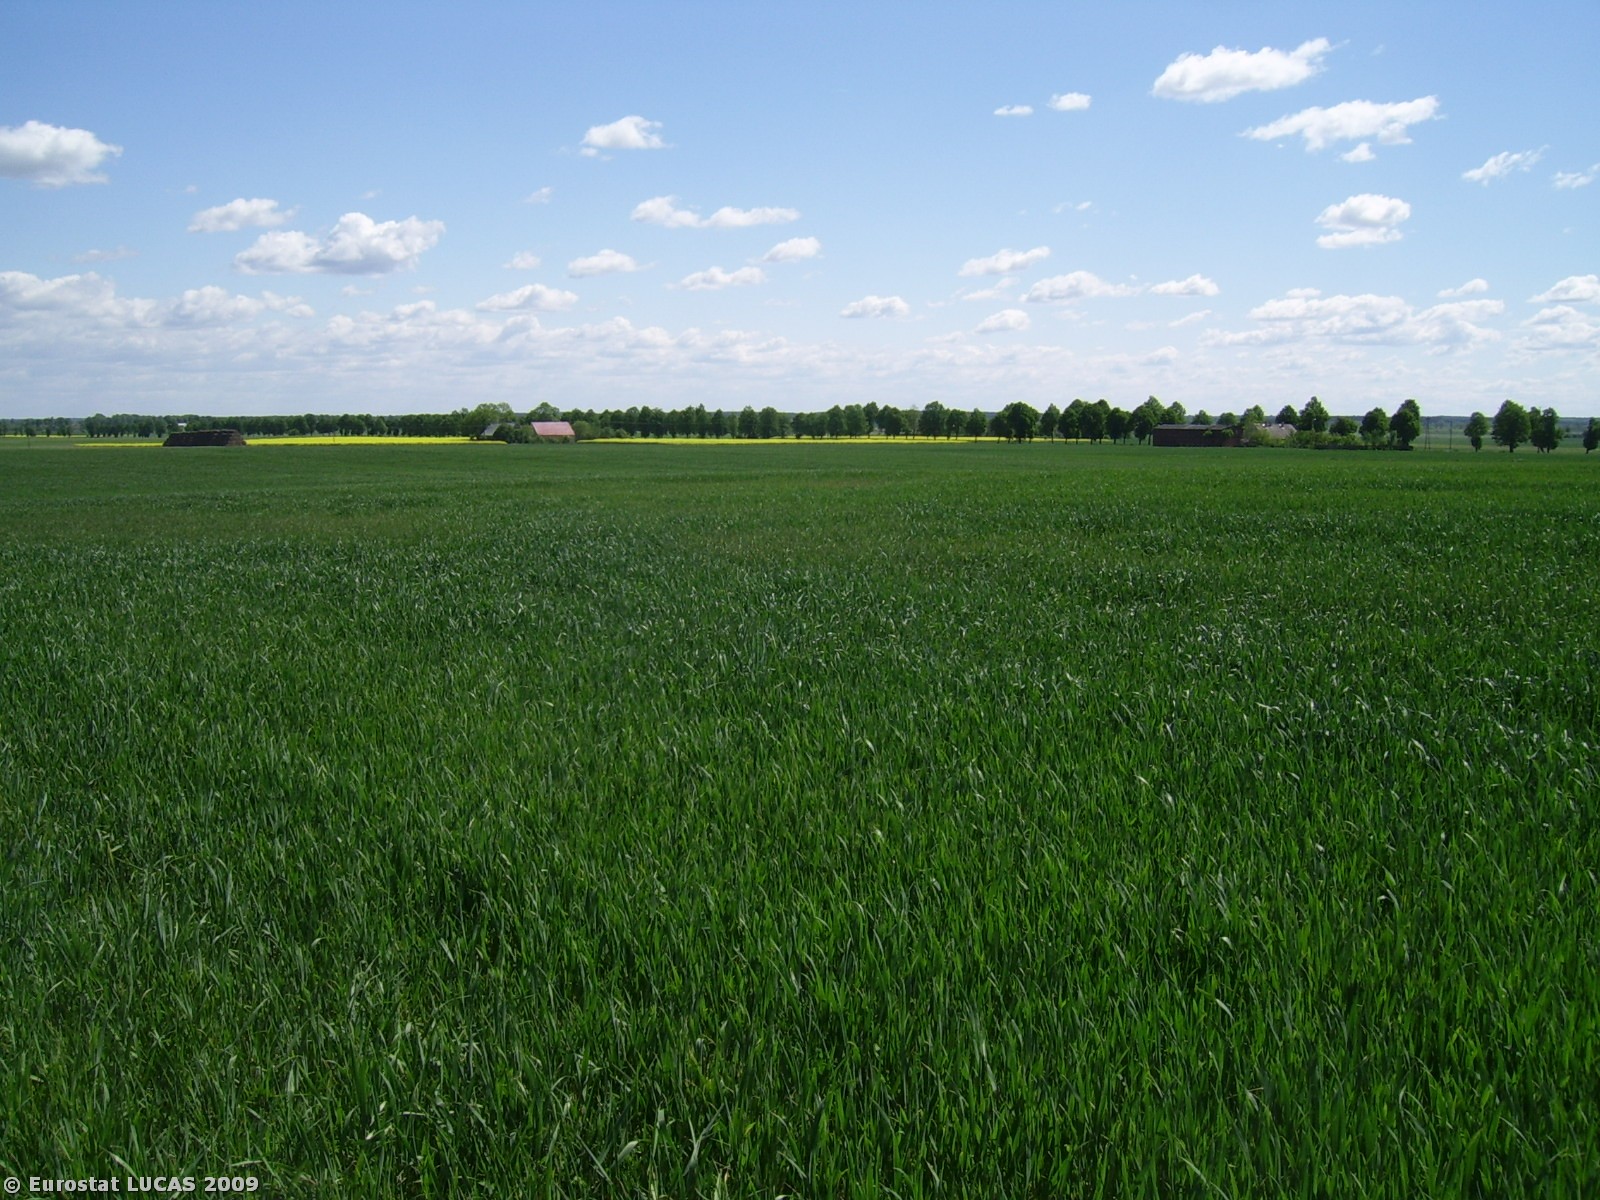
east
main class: Cropland
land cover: Common wheat
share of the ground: > 75 %
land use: Agriculture (excluding fallow land and kitchen gardens)
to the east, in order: Common wheat
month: May
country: PL
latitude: 52.5313
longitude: 17.8718
